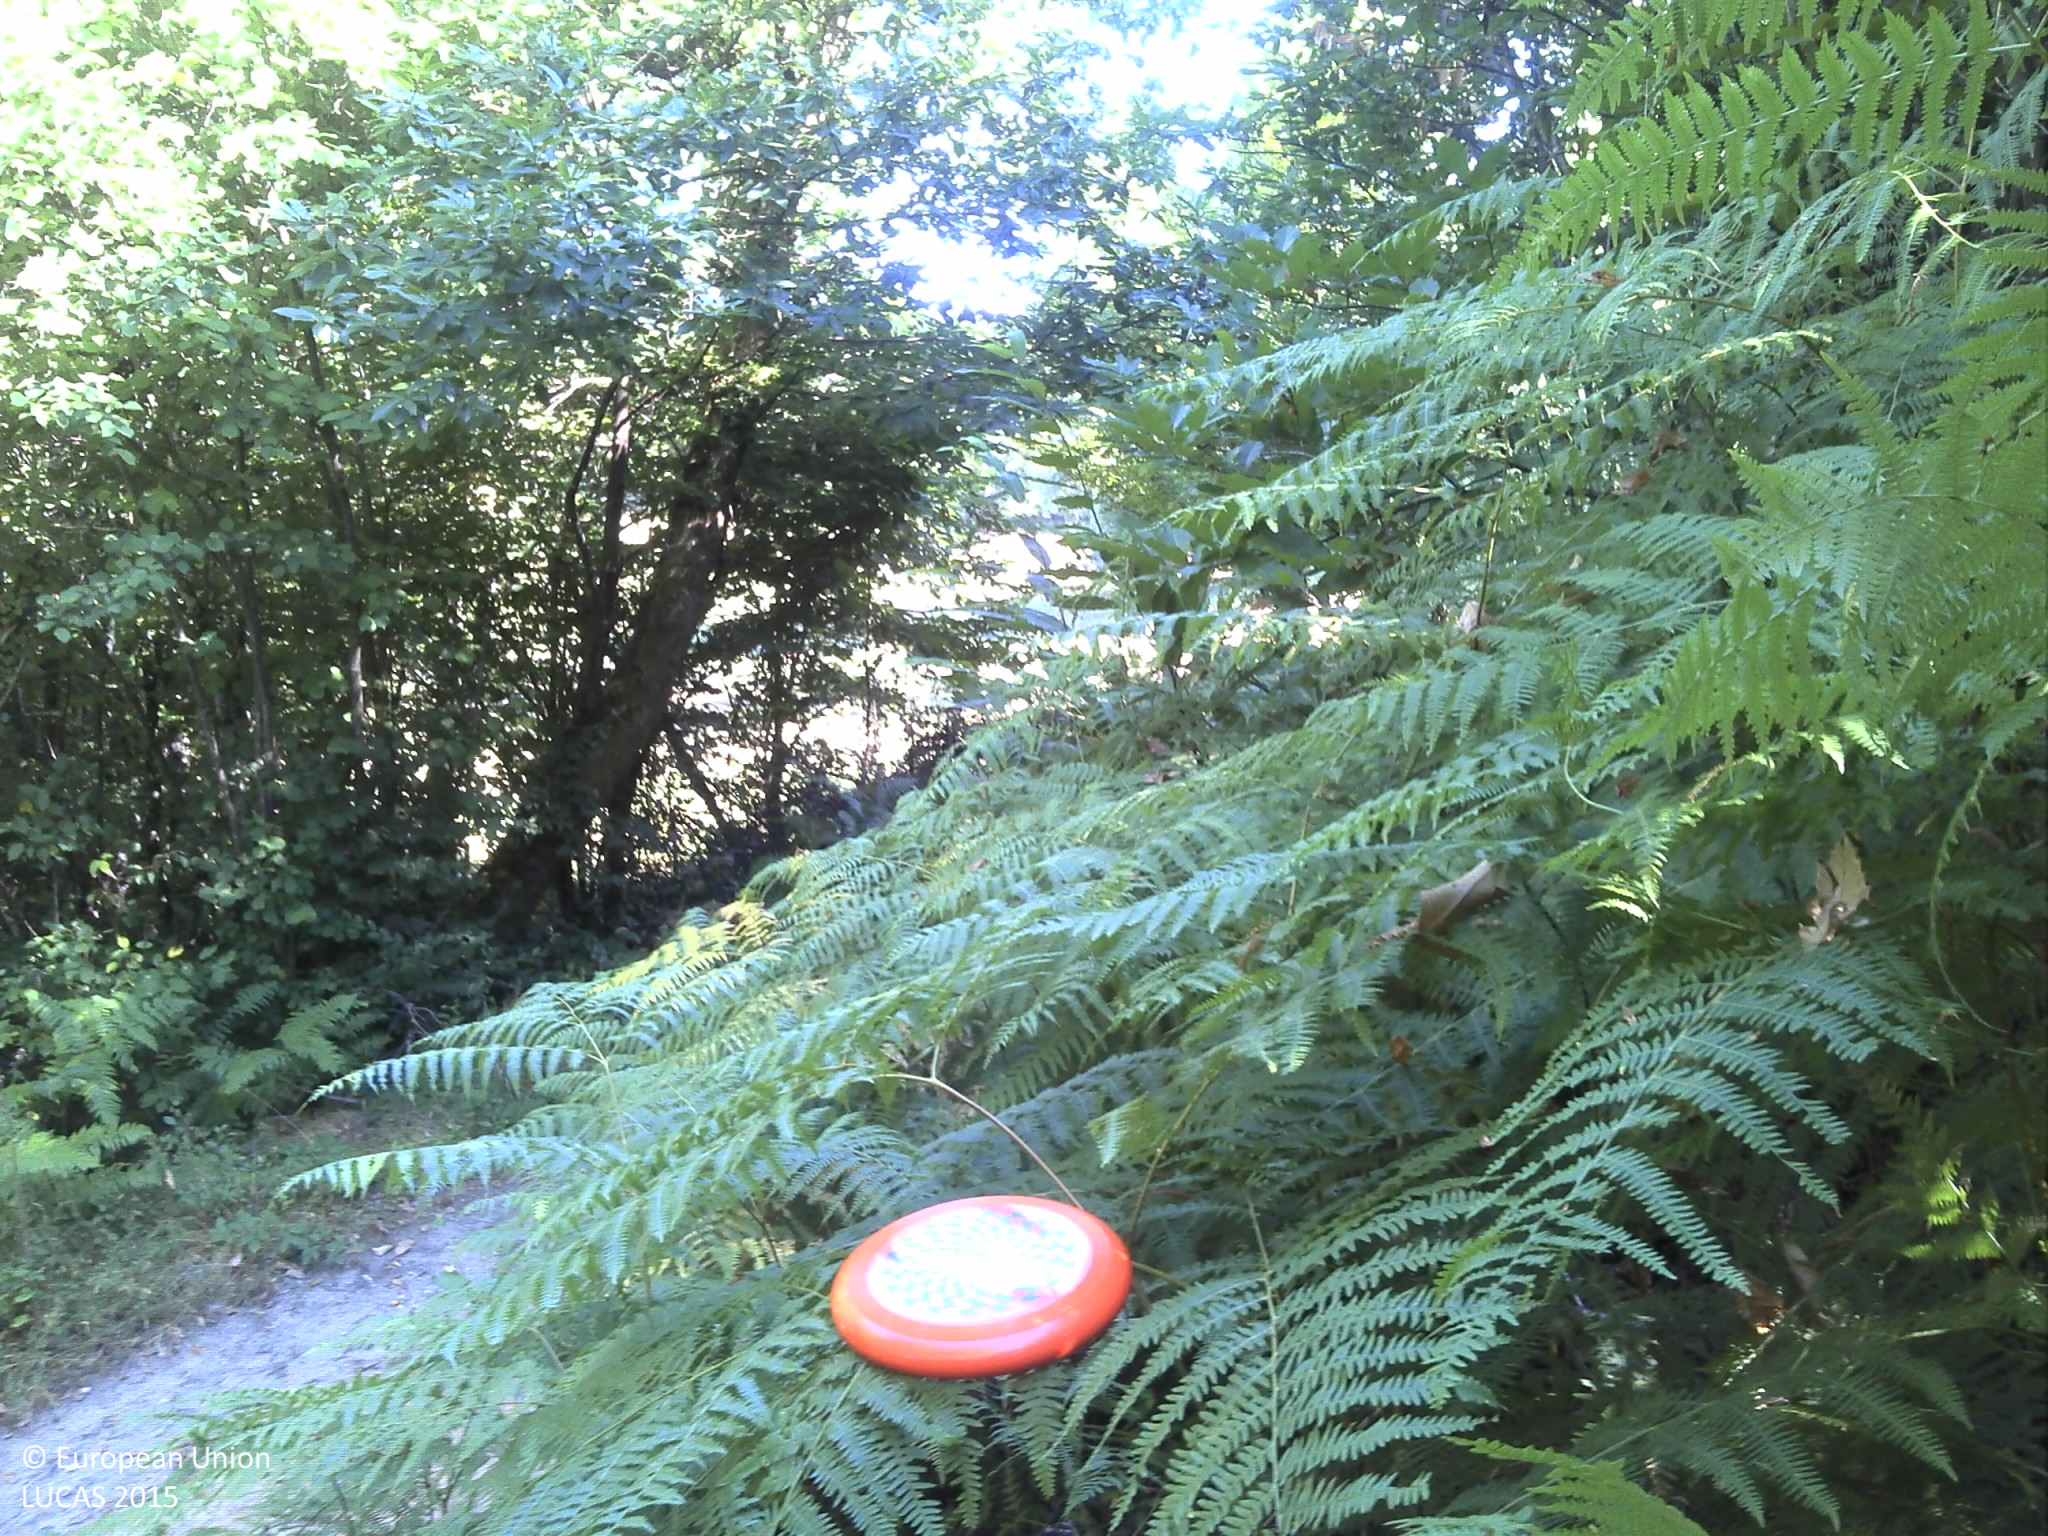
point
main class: Woodland
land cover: Broadleaved woodland
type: acidophilous oak and oak-birch forest
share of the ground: > 75 %
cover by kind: broadleaved forest trees 50 %, herbaceous plants 40 %, lichens and mosses 5 %, unconsolidated bare surface 5 %
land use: Forestry
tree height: > 5 m
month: July
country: FR
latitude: 45.0767
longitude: 1.8038
